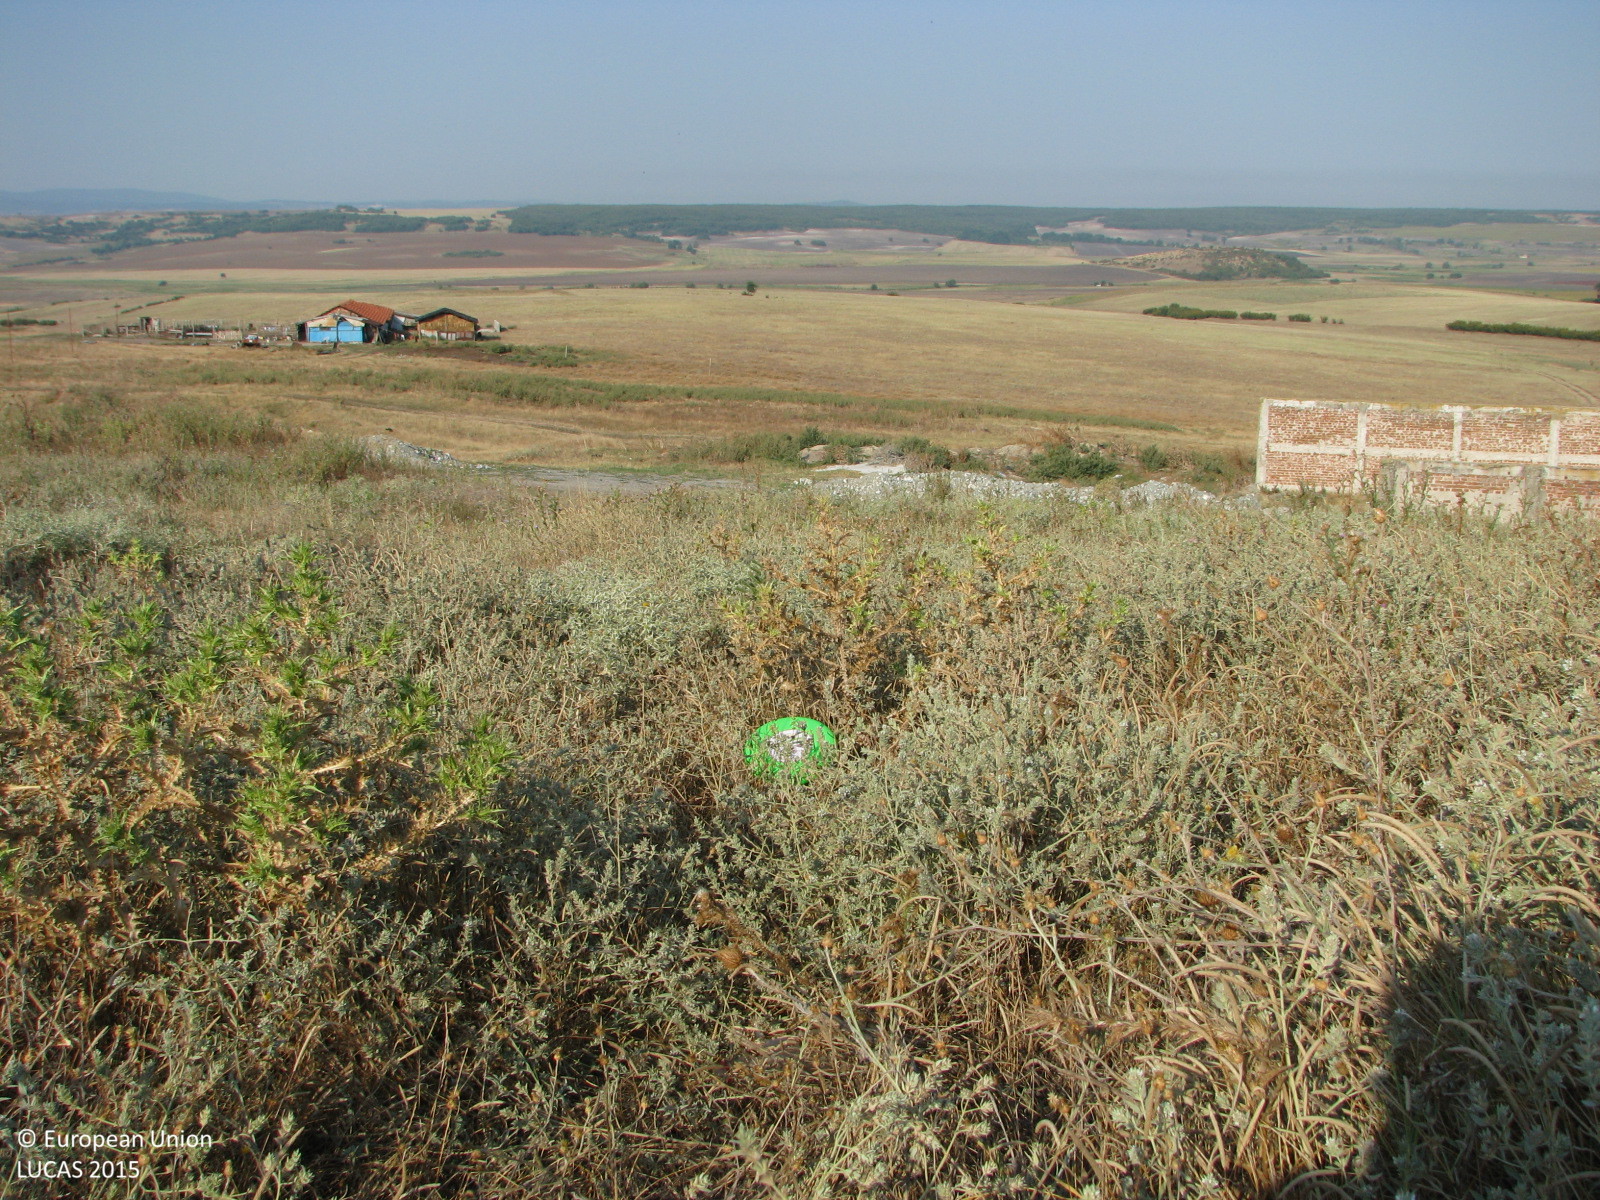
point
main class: Grassland
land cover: Spontaneously vegetated surfaces
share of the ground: > 75 %
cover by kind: herbaceous plants 100 %
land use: Agriculture (excluding fallow land and kitchen gardens)
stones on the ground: < 10 %
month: August
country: BG
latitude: 42.1703
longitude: 26.5150
